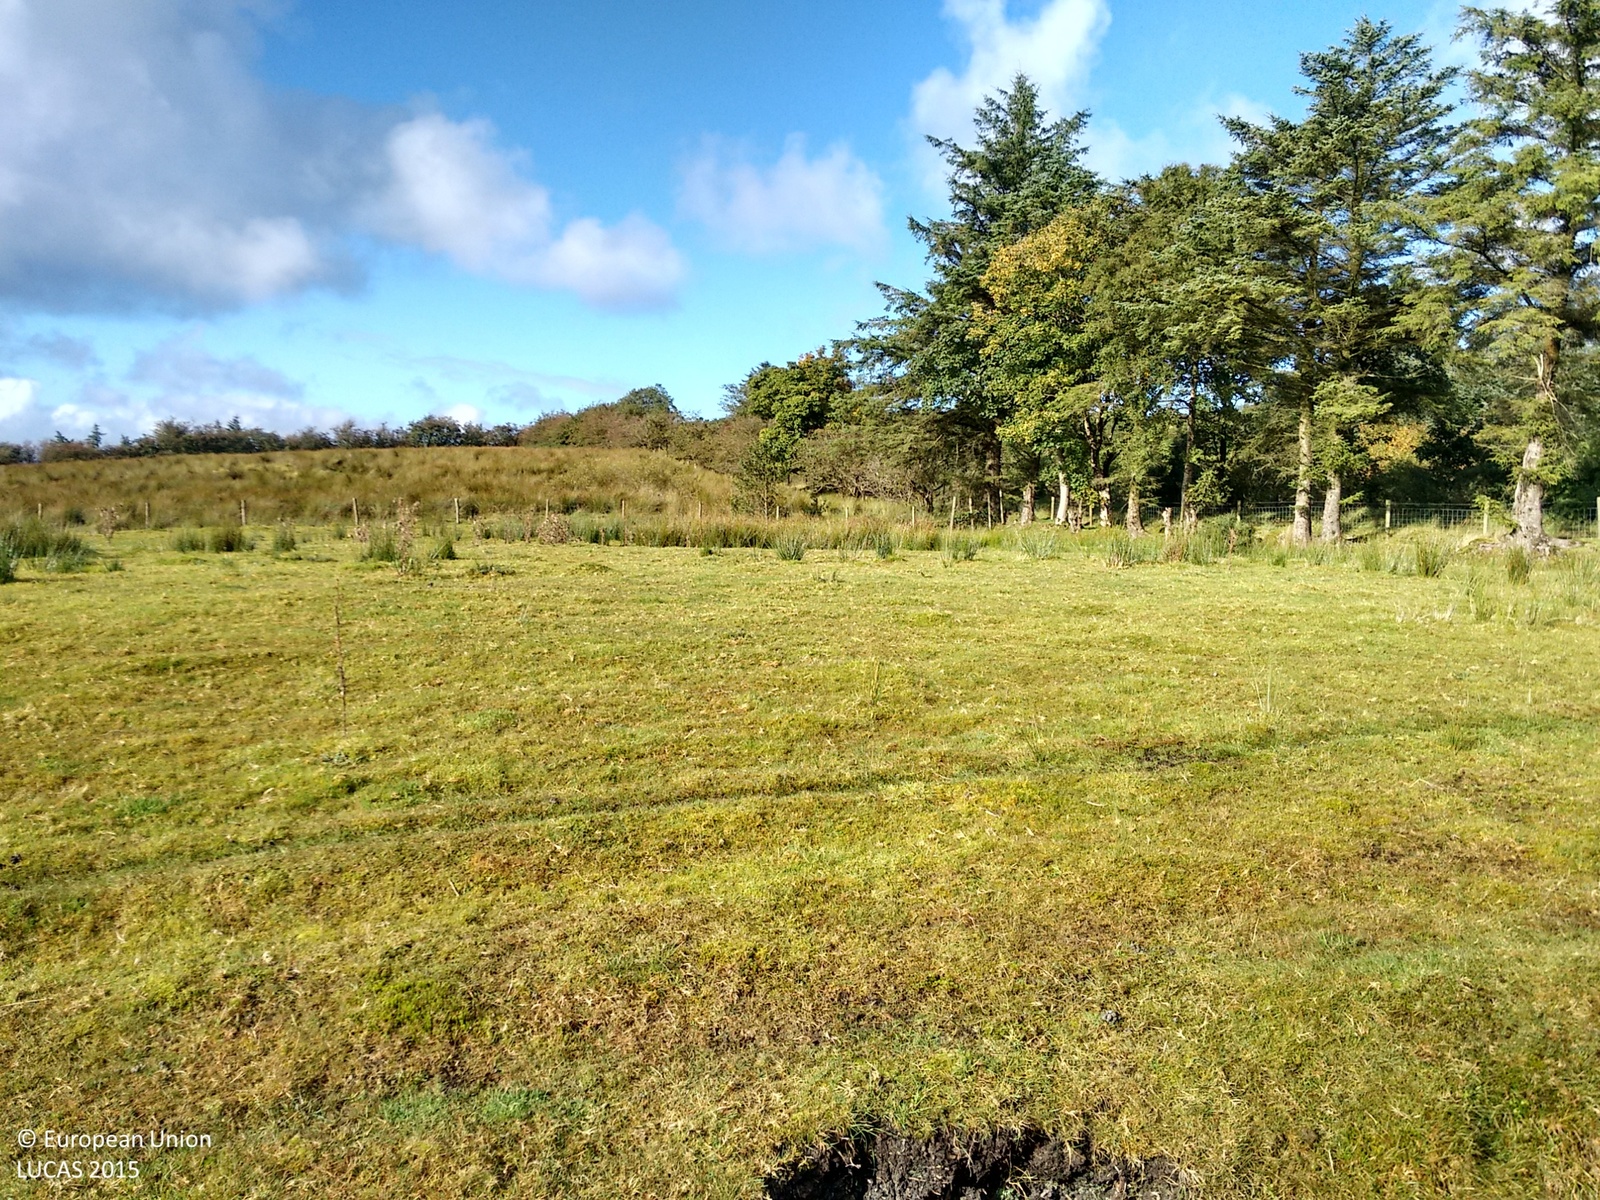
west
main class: Grassland
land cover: Grassland without tree/shrub cover
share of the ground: > 75 %
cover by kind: herbaceous plants 100 %
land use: Agriculture (excluding fallow land and kitchen gardens)
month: September
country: IE
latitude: 55.1773
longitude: -7.4722
